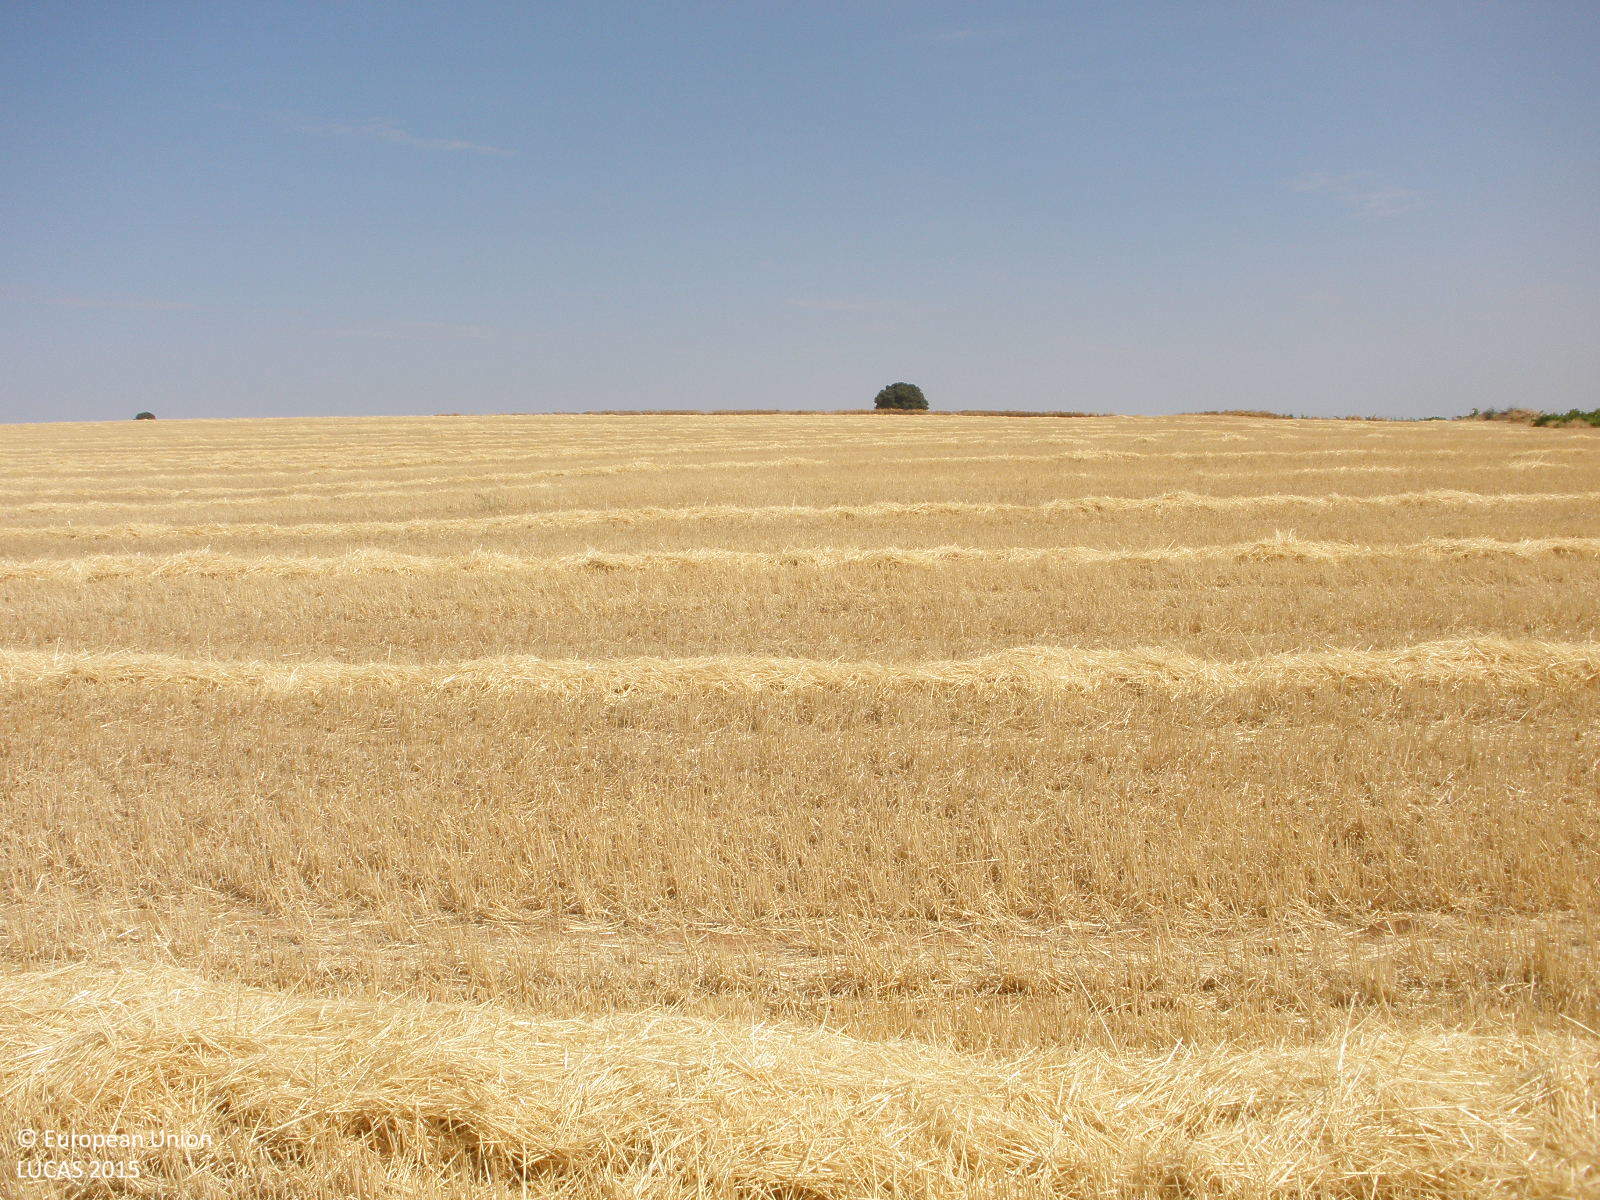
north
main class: Cropland
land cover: Barley
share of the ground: < 10 %
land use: Agriculture (excluding fallow land and kitchen gardens)
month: July
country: ES
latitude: 39.8749
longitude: -3.1301
